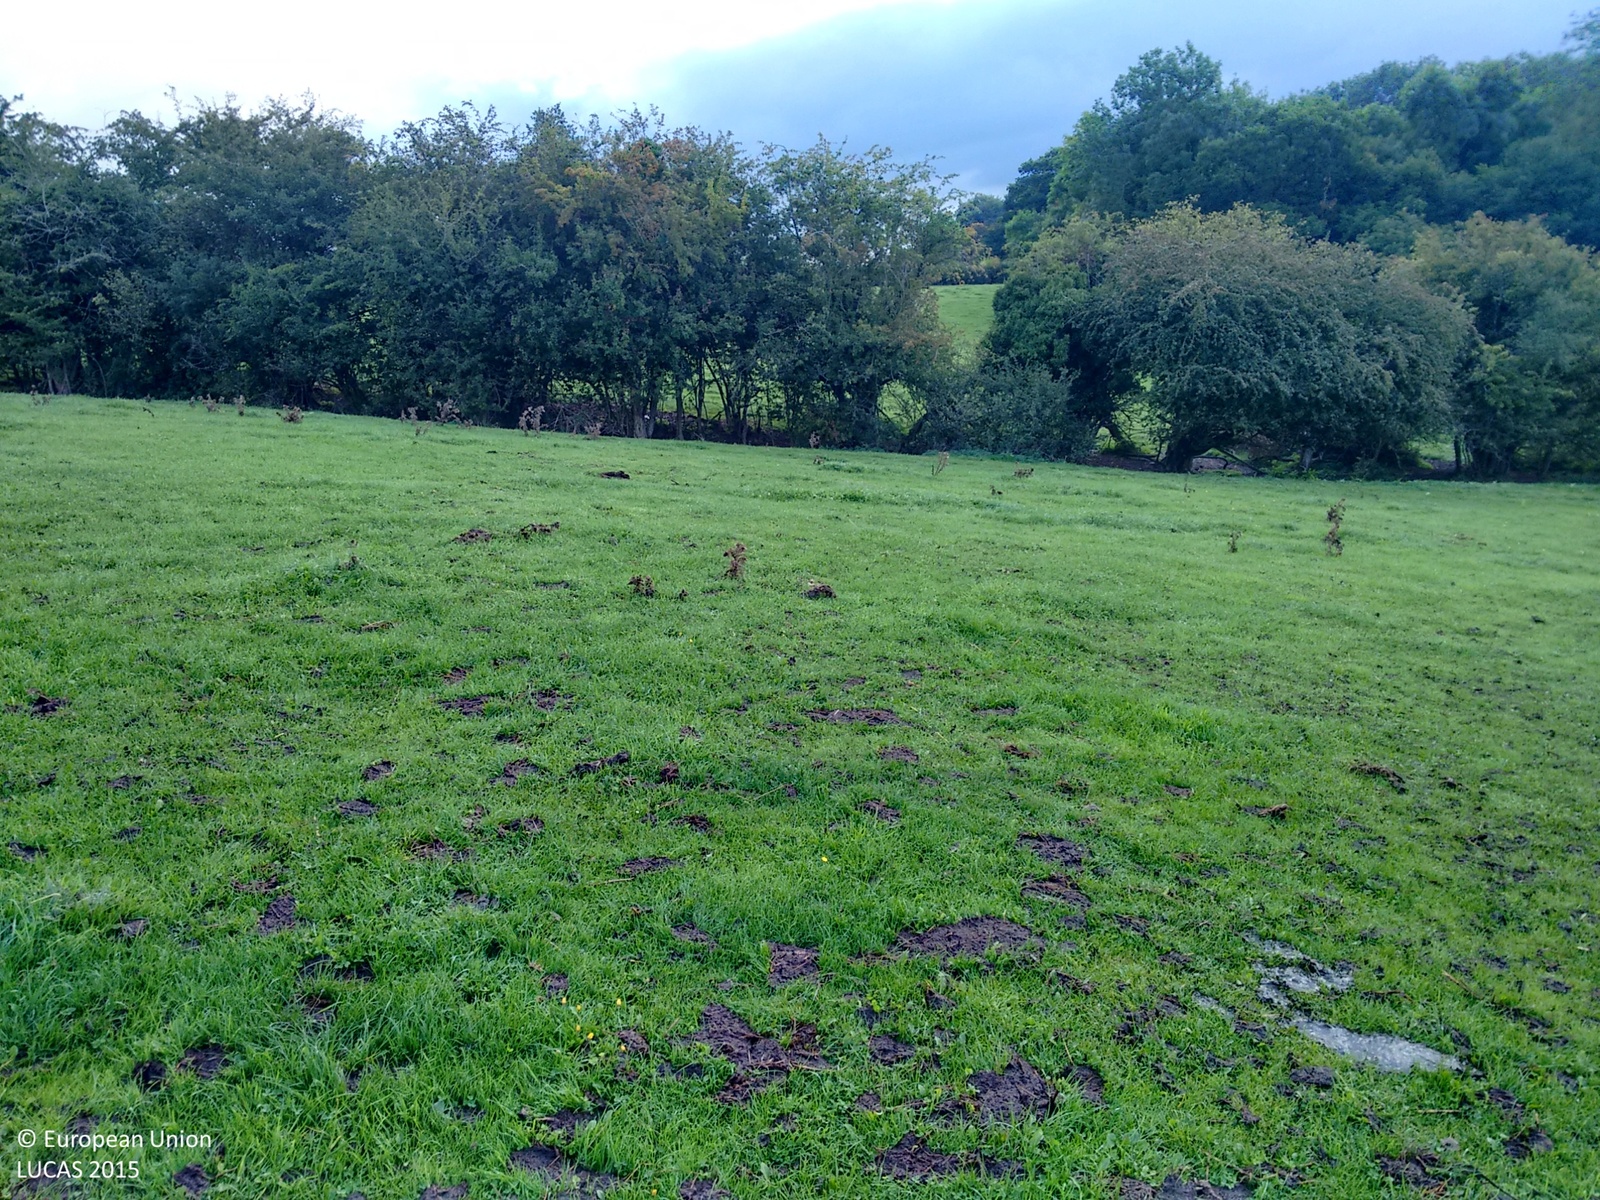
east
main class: Grassland
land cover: Grassland without tree/shrub cover
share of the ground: > 75 %
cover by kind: herbaceous plants 100 %
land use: Agriculture (excluding fallow land and kitchen gardens)
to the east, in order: Grassland without tree/shrub cover; Abandoned hedges; Grassland without tree/shrub cover; Managed hedges; Grassland without tree/shrub cover; Fences; Broadleaved woodland
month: September
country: GB
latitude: 52.7172
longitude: -3.1495
